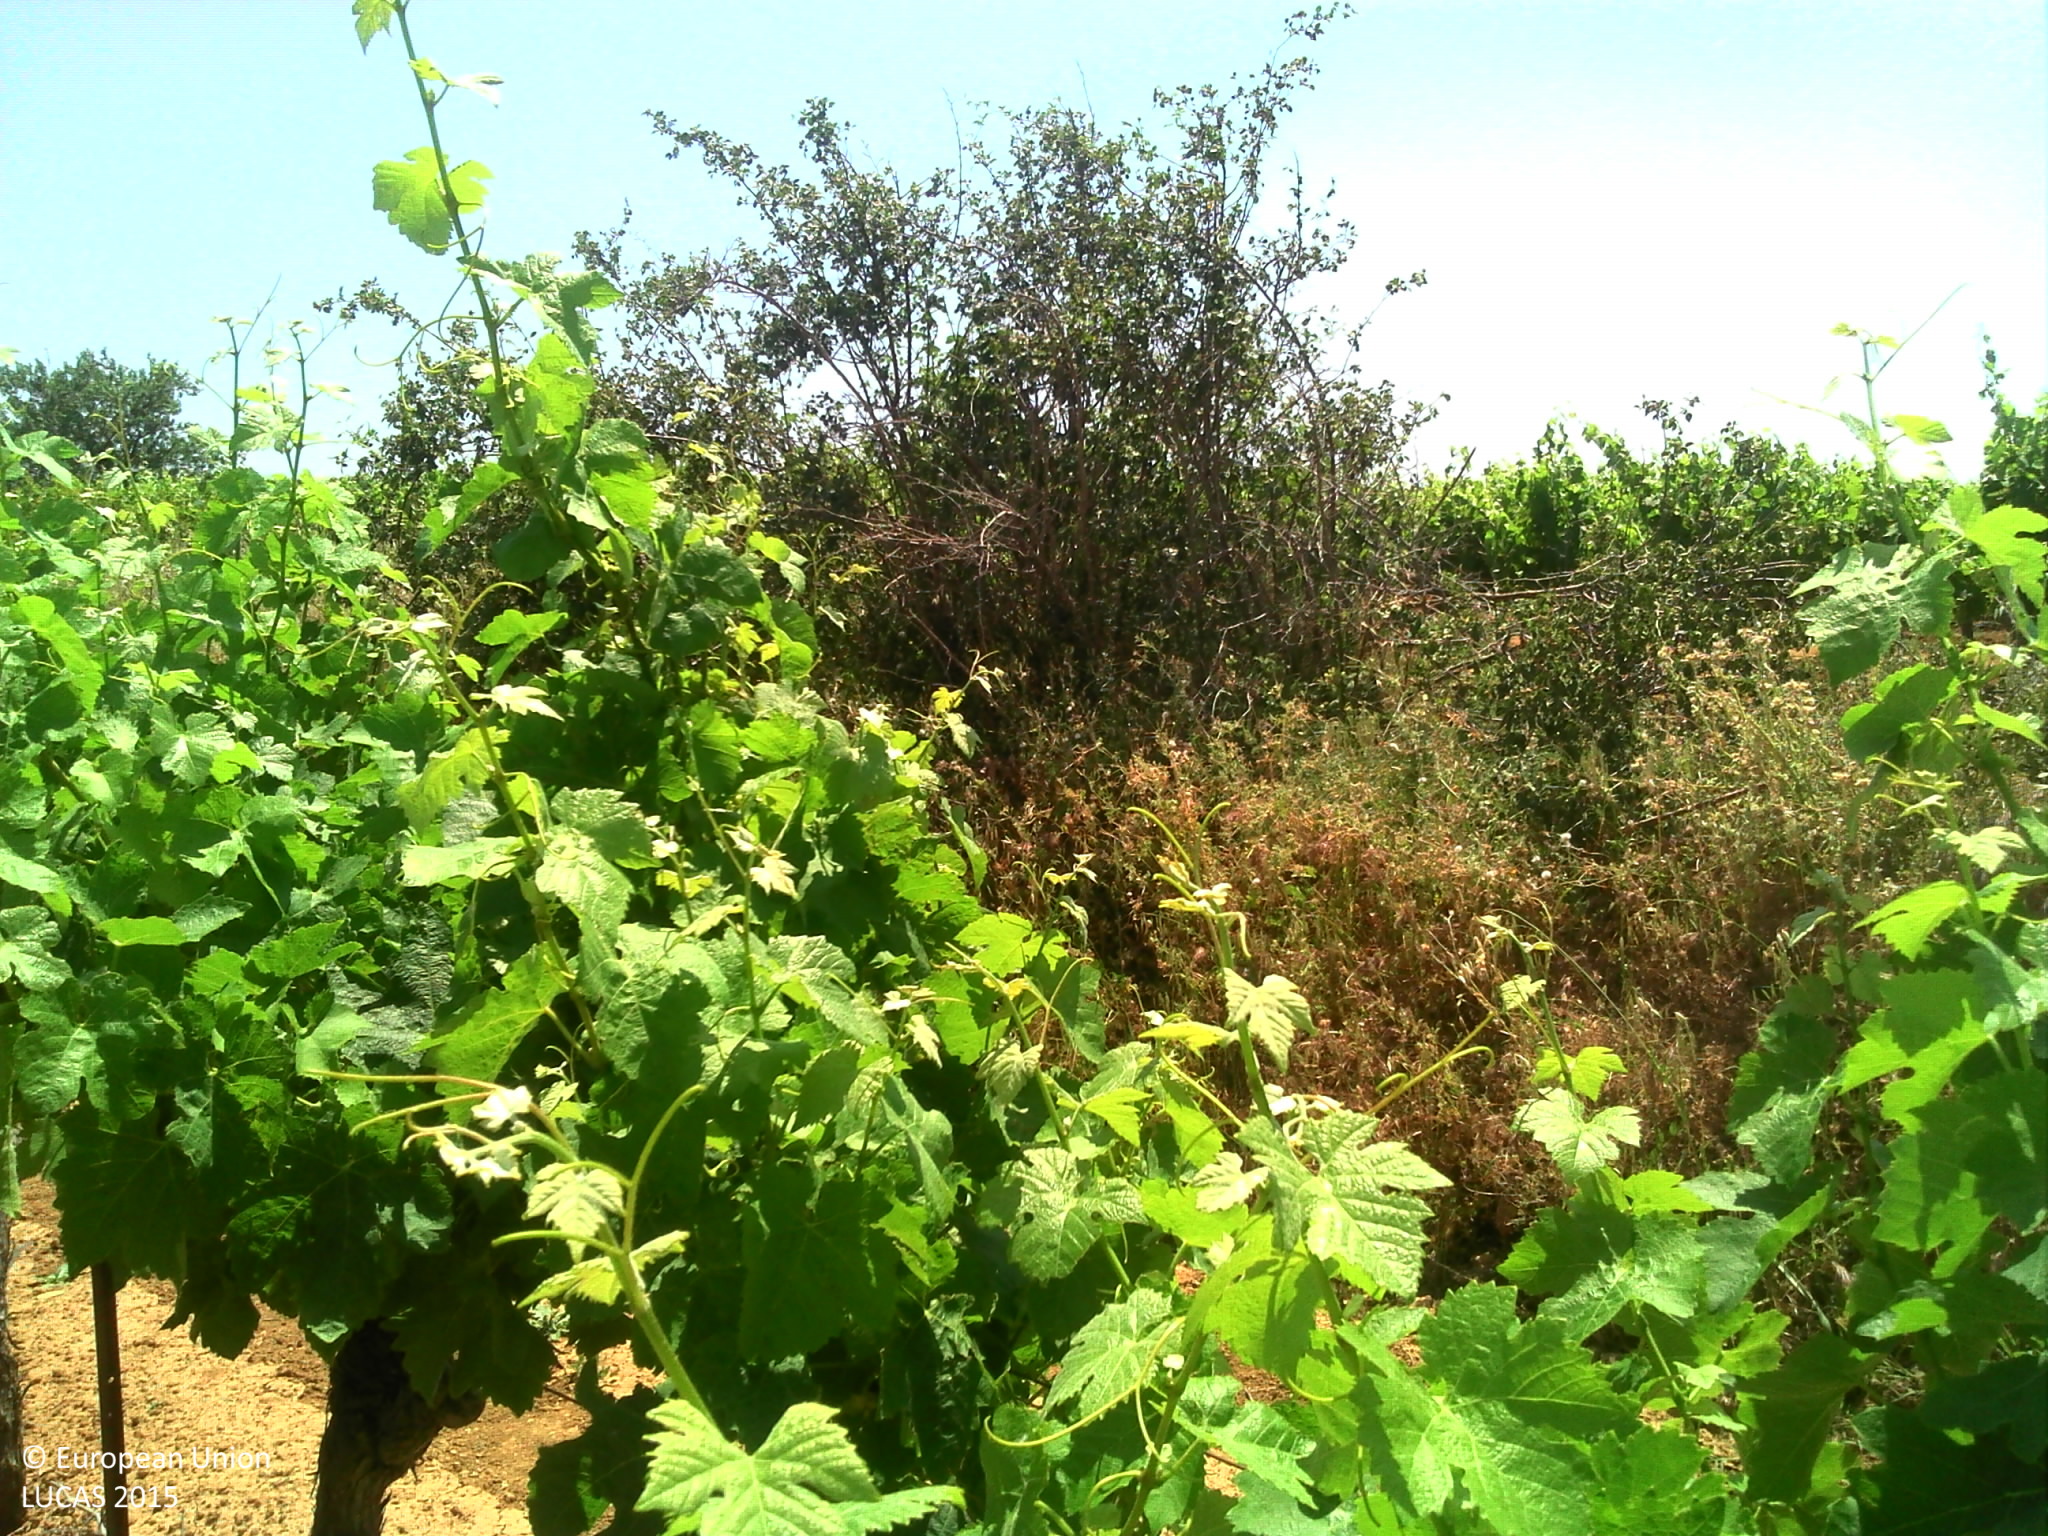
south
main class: Cropland
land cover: Vineyards
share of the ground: > 75 %
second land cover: Other bare soil
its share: > 75 %
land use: Agriculture (excluding fallow land and kitchen gardens)
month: June
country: FR
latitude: 43.2338
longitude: 3.1018
